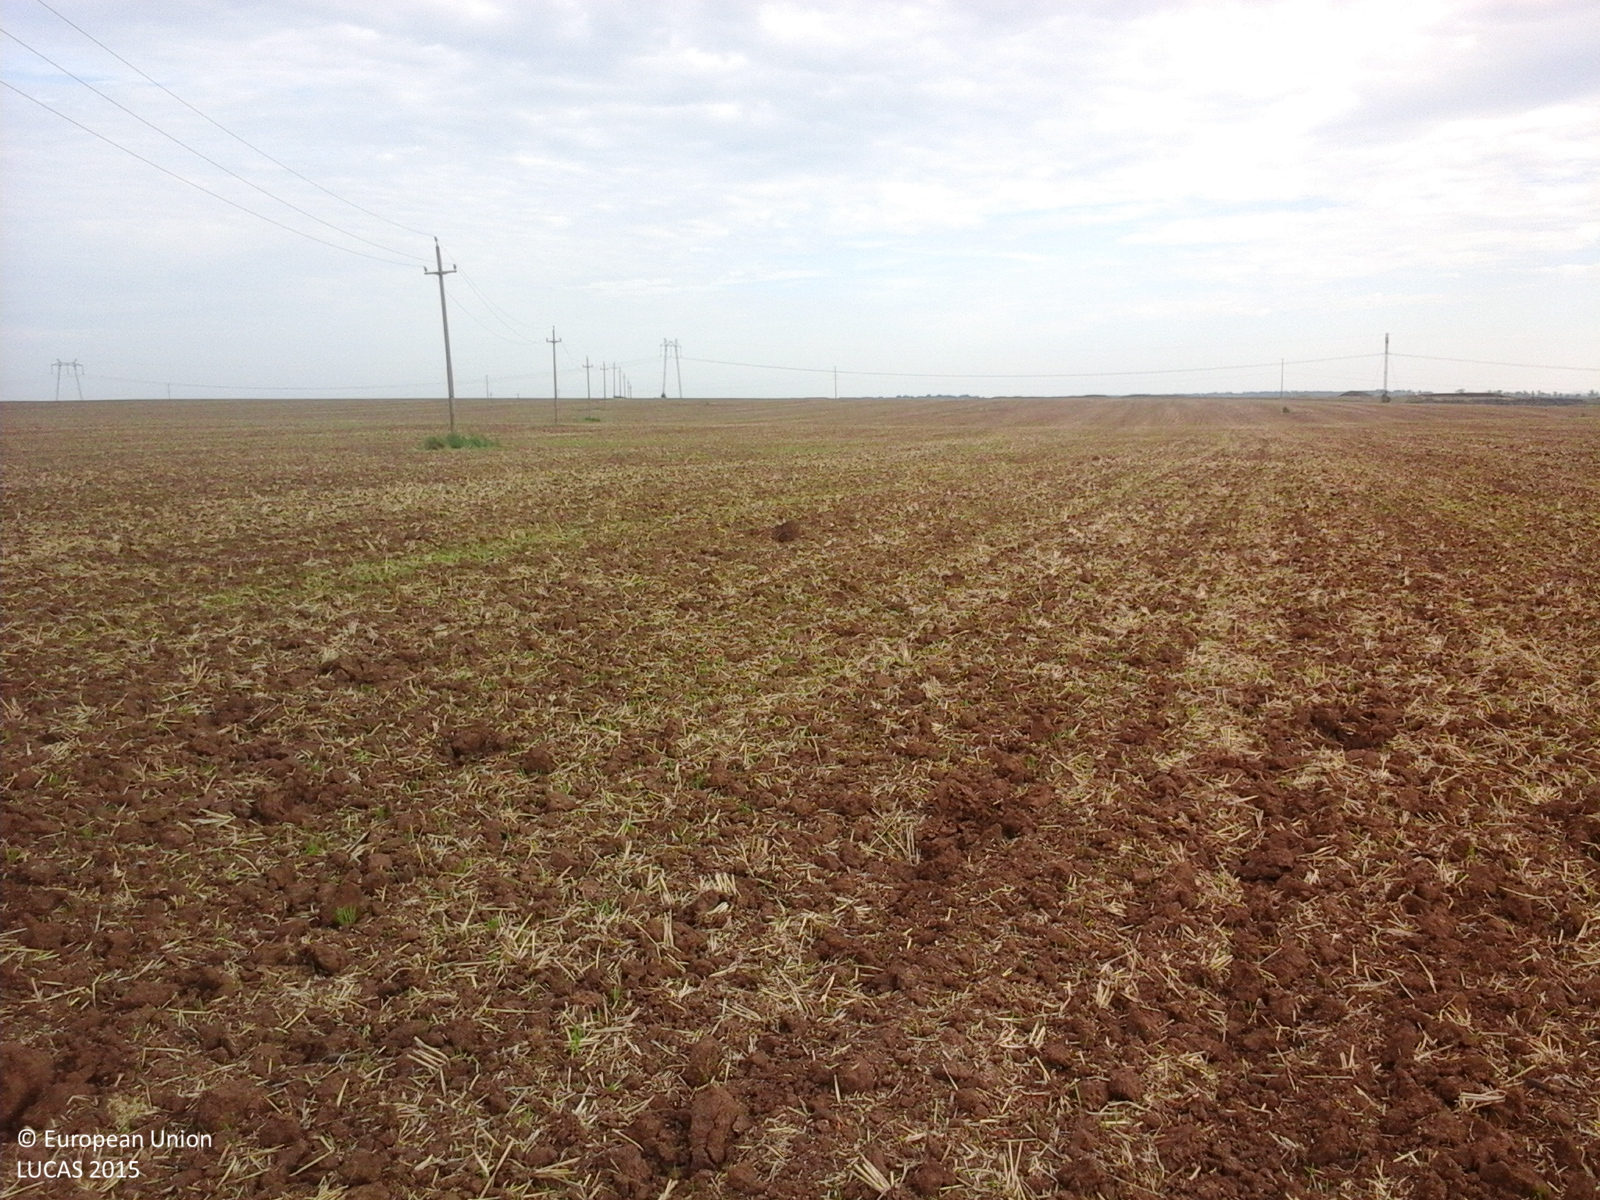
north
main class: Cropland
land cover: Common wheat
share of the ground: 10 - 25 %
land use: Agriculture (excluding fallow land and kitchen gardens)
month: August
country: RO
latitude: 46.1026
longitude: 21.4056
